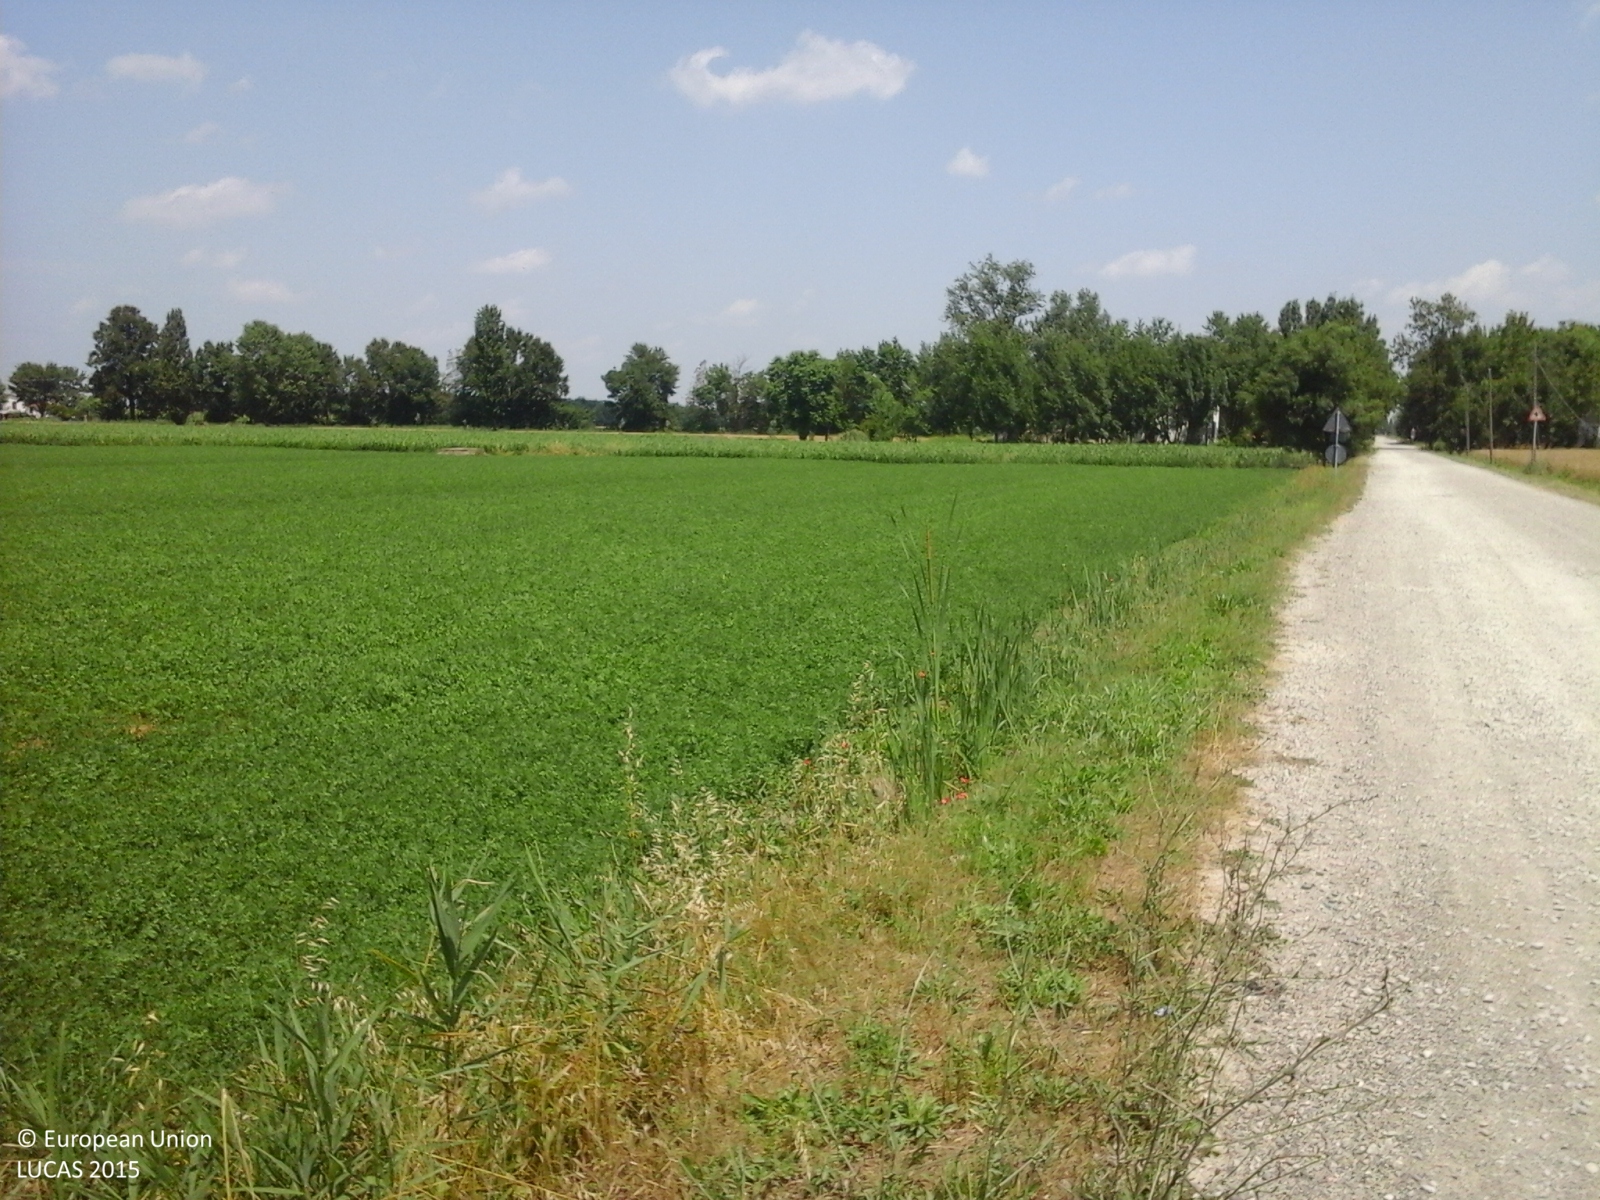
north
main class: Woodland
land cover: Broadleaved woodland
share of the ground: > 75 %
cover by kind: broadleaved forest trees 100 %
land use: Residential
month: June
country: IT
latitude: 44.8137
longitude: 11.0979
